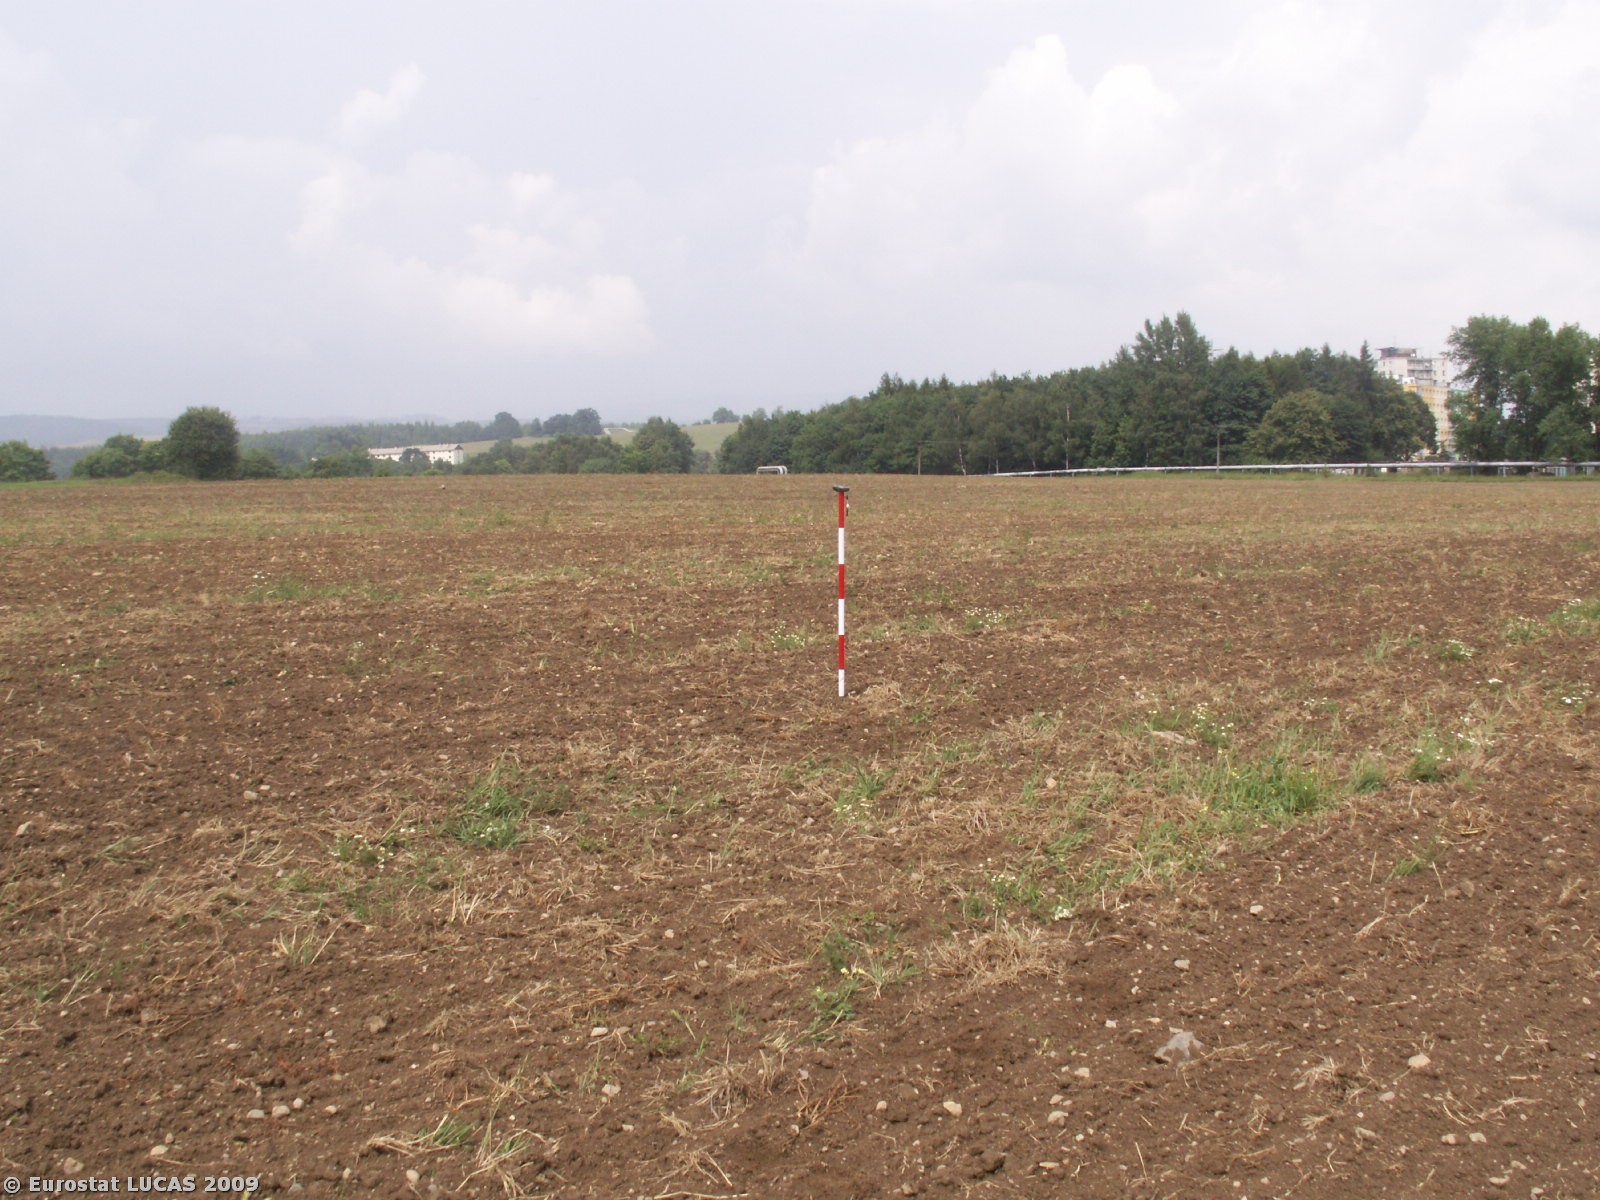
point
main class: Cropland
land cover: Other fibre and oleaginous crops
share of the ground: < 10 %
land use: Agriculture (excluding fallow land and kitchen gardens)
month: June
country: CZ
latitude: 50.2415
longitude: 12.7340
